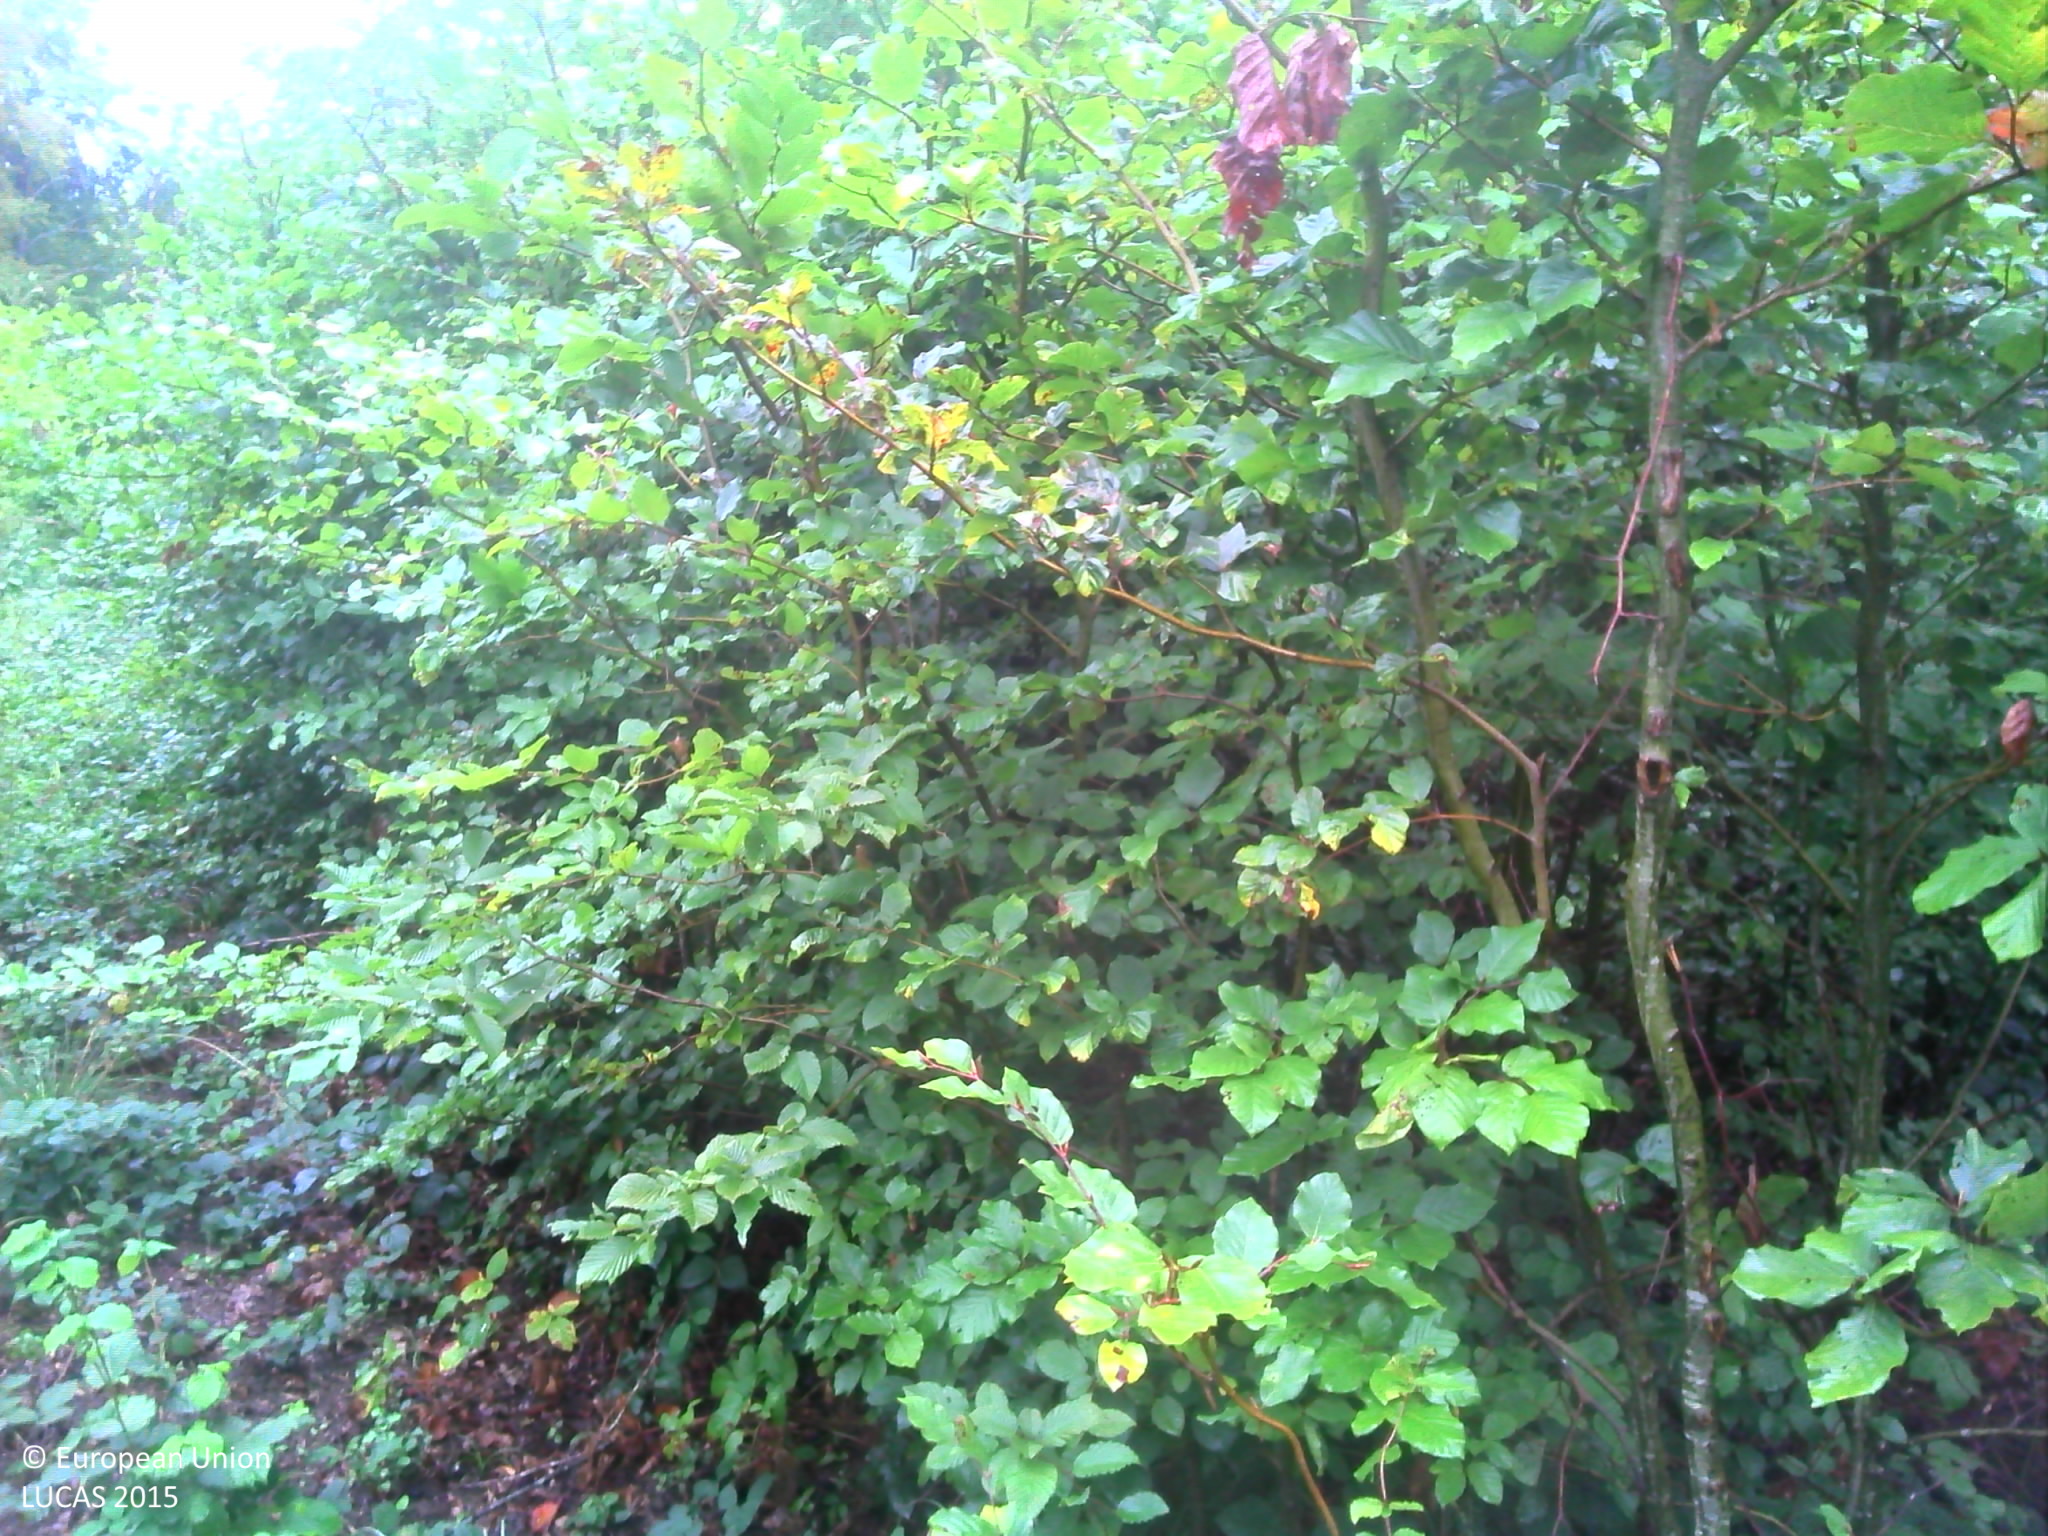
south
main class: Woodland
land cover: Broadleaved woodland
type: mesophytic deciduous forest
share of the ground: > 75 %
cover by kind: broadleaved forest trees 60 %, shrubs 20 %, herbaceous plants 10 %, consolidated bare surface 10 %
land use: Forestry
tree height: < 5 m
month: September
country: FR
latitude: 47.1694
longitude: 6.2684
